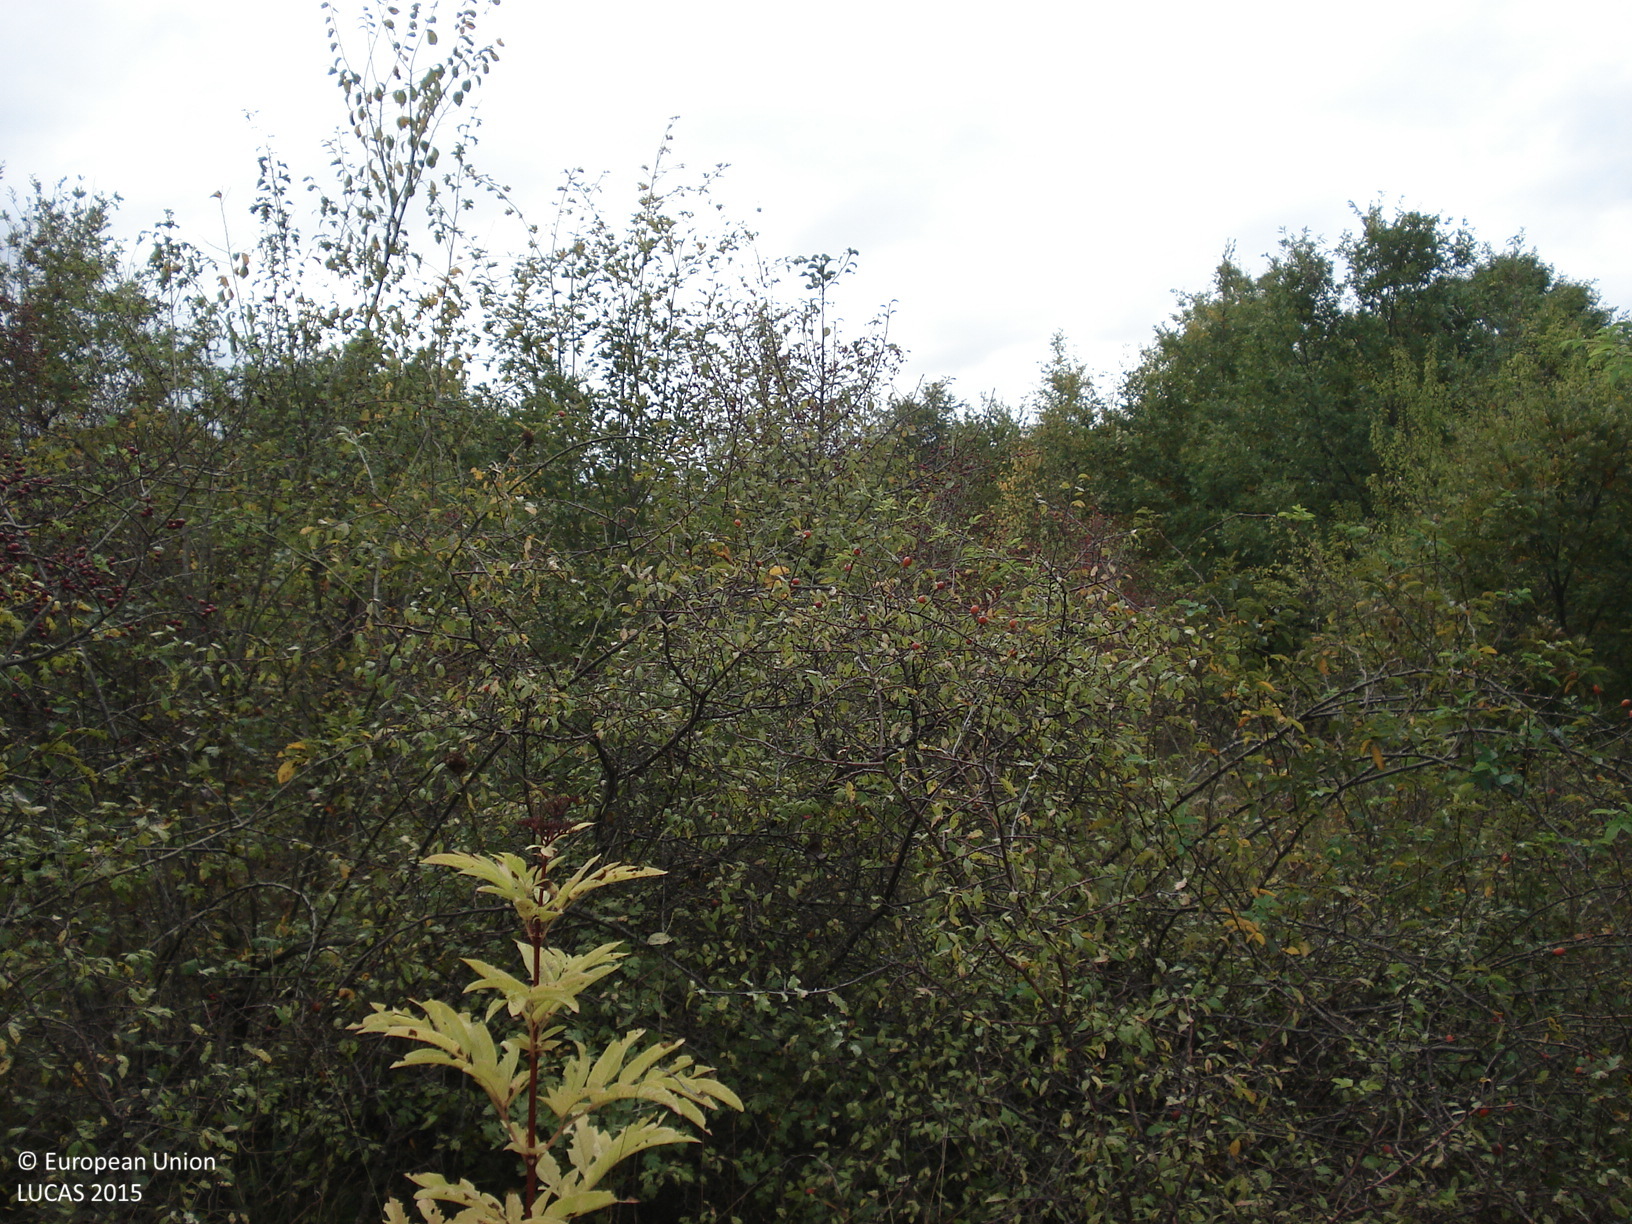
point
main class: Woodland
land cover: Broadleaved woodland
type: mesophytic deciduous forest
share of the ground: > 75 %
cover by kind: broadleaved forest trees 80 %, shrubs 10 %, herbaceous plants 10 %
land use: Forestry
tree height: > 5 m
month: October
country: BG
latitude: 42.9928
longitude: 25.7439
